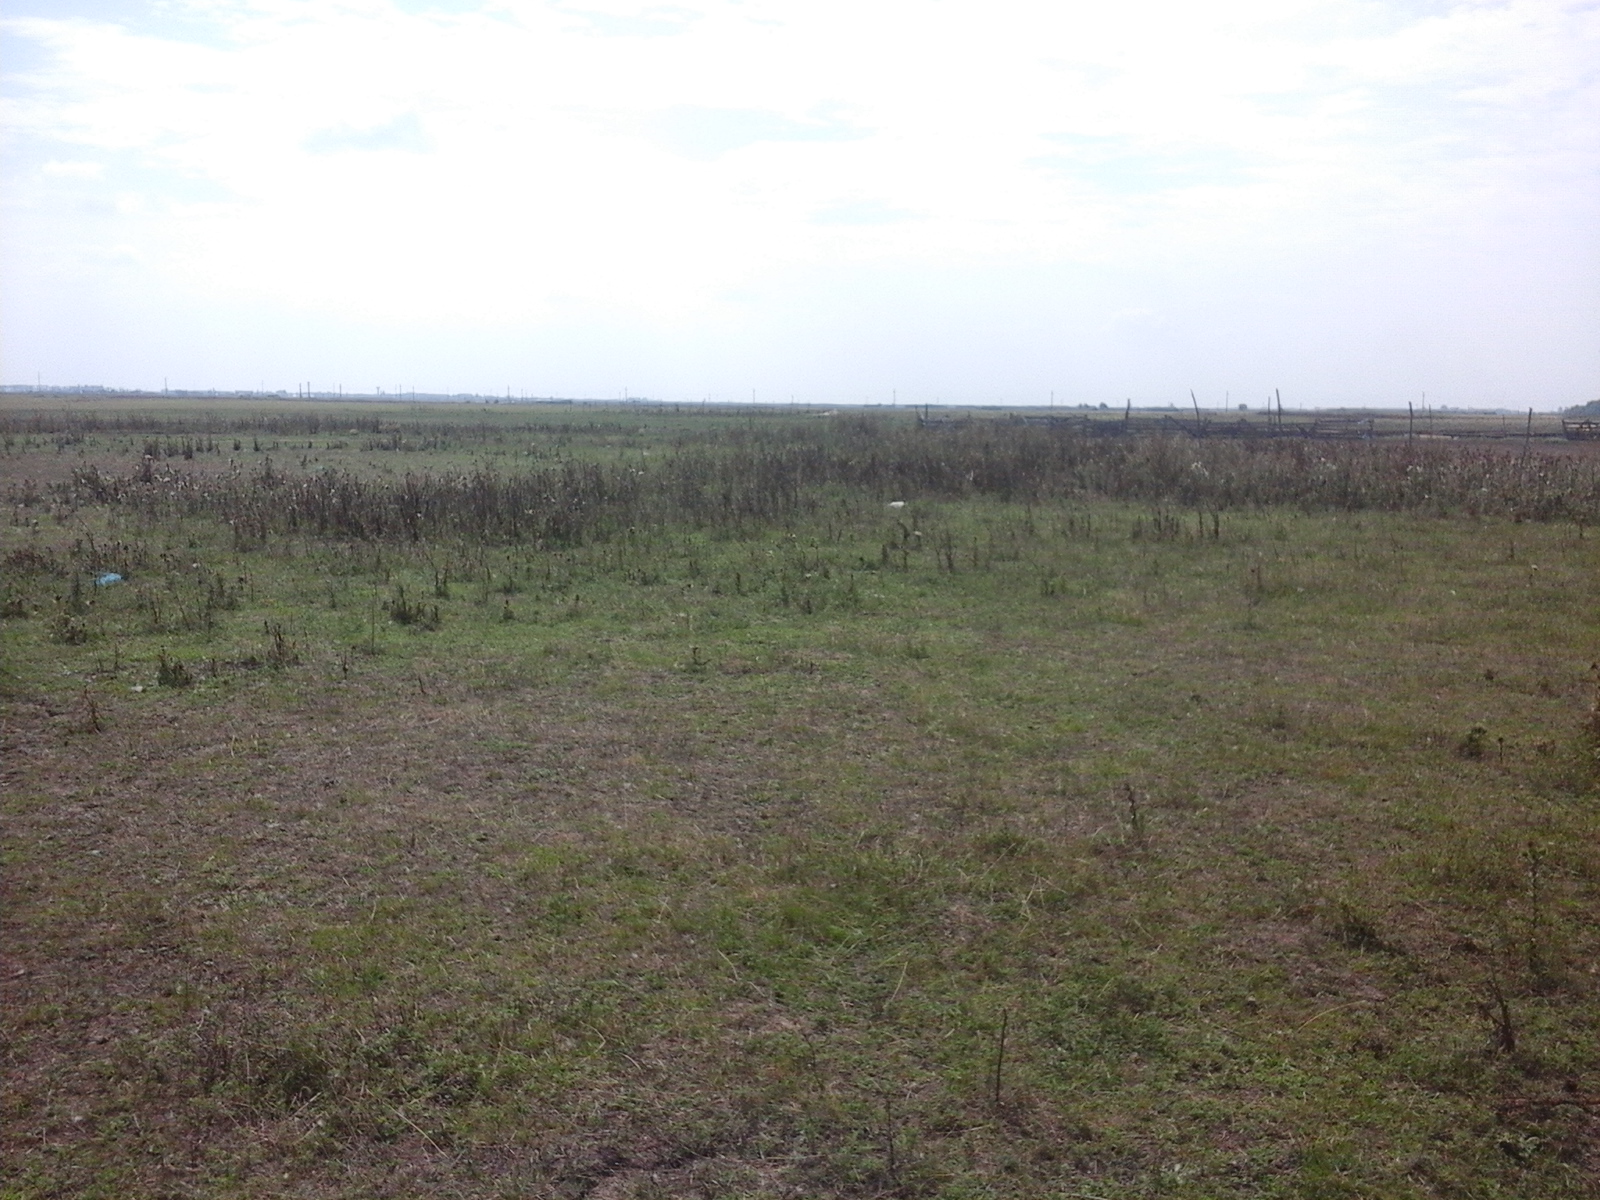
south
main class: Grassland
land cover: Grassland without tree/shrub cover
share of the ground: > 75 %
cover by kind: herbaceous plants 100 %
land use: Agriculture (excluding fallow land and kitchen gardens)
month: August
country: RO
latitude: 46.5824
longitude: 21.5093
